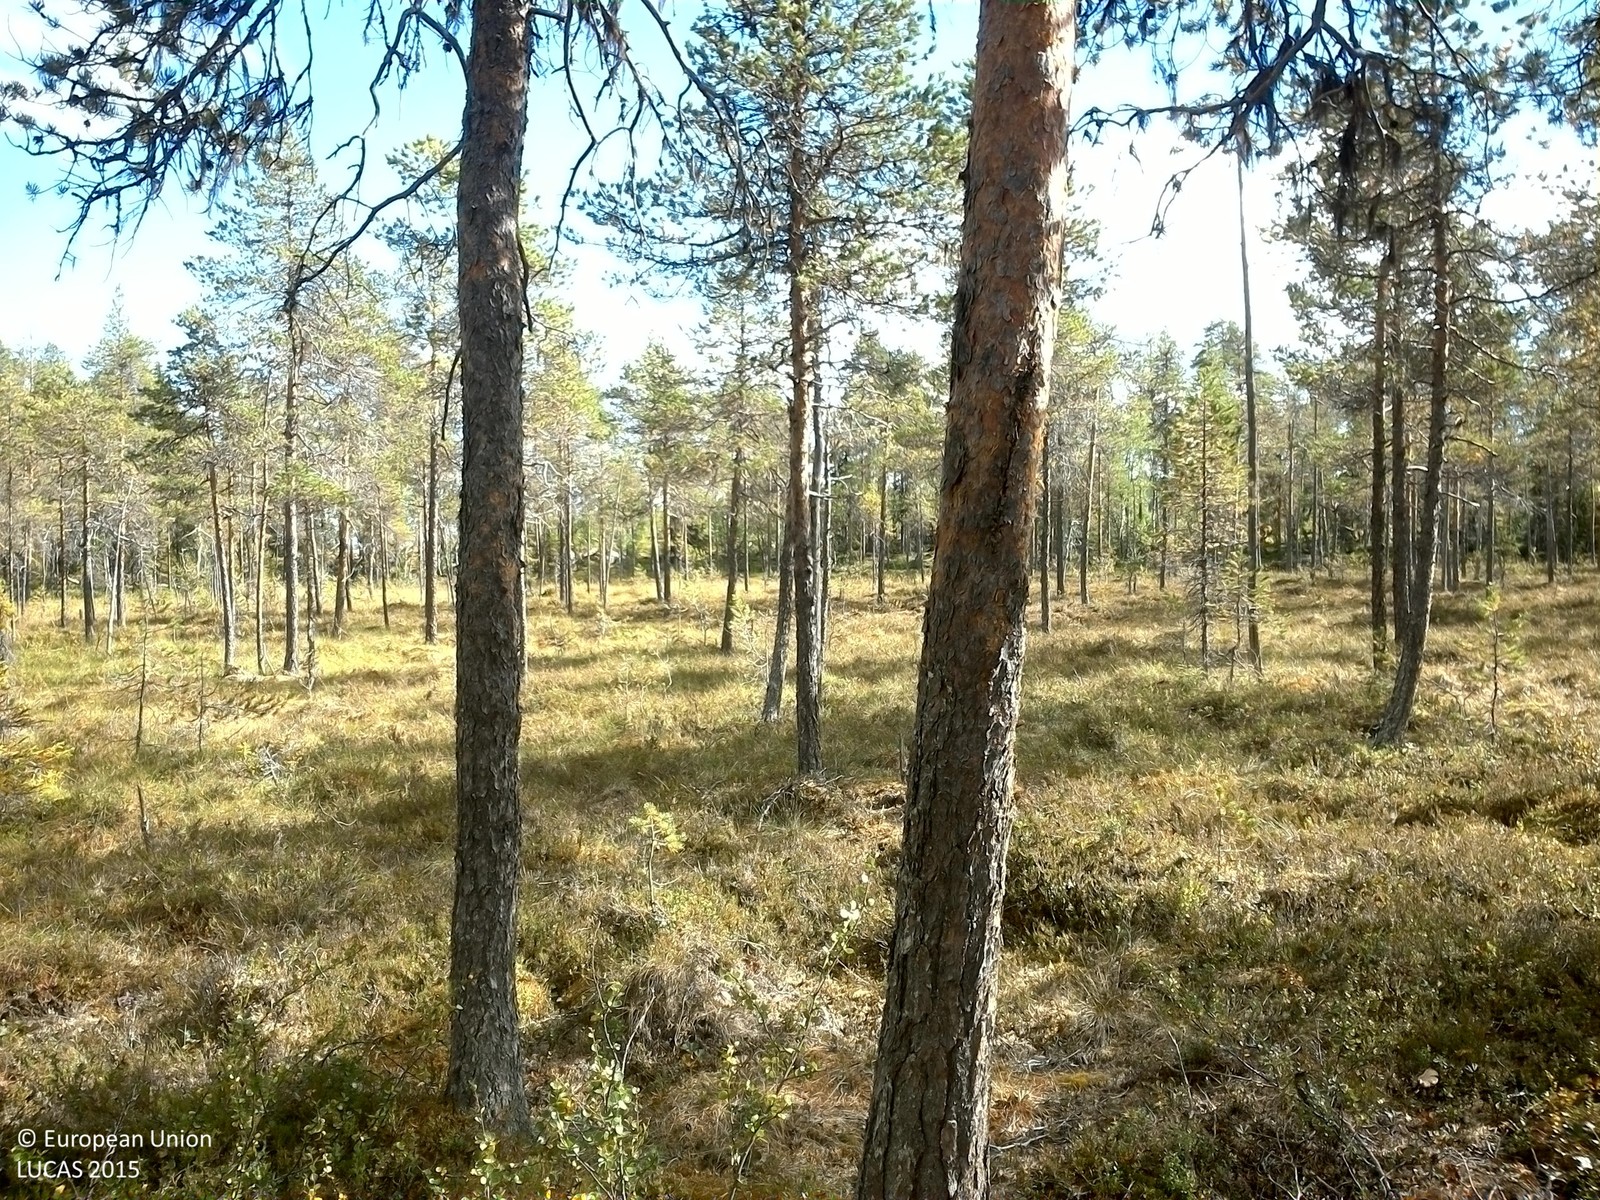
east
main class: Woodland
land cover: Pine dominated coniferous woodland
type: boreal forest
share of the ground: 10 - 25 %
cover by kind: shrubs 40 %, lichens and mosses 35 %, coniferous forest trees 20 %, herbaceous plants 5 %
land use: Semi-natural and natural areas not in use
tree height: > 5 m
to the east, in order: Pine dominated coniferous woodland; Pine dominated mixed woodland; Spruce dominated mixed woodland; Pine dominated mixed woodland
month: August
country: SE
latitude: 64.0240
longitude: 17.4396
